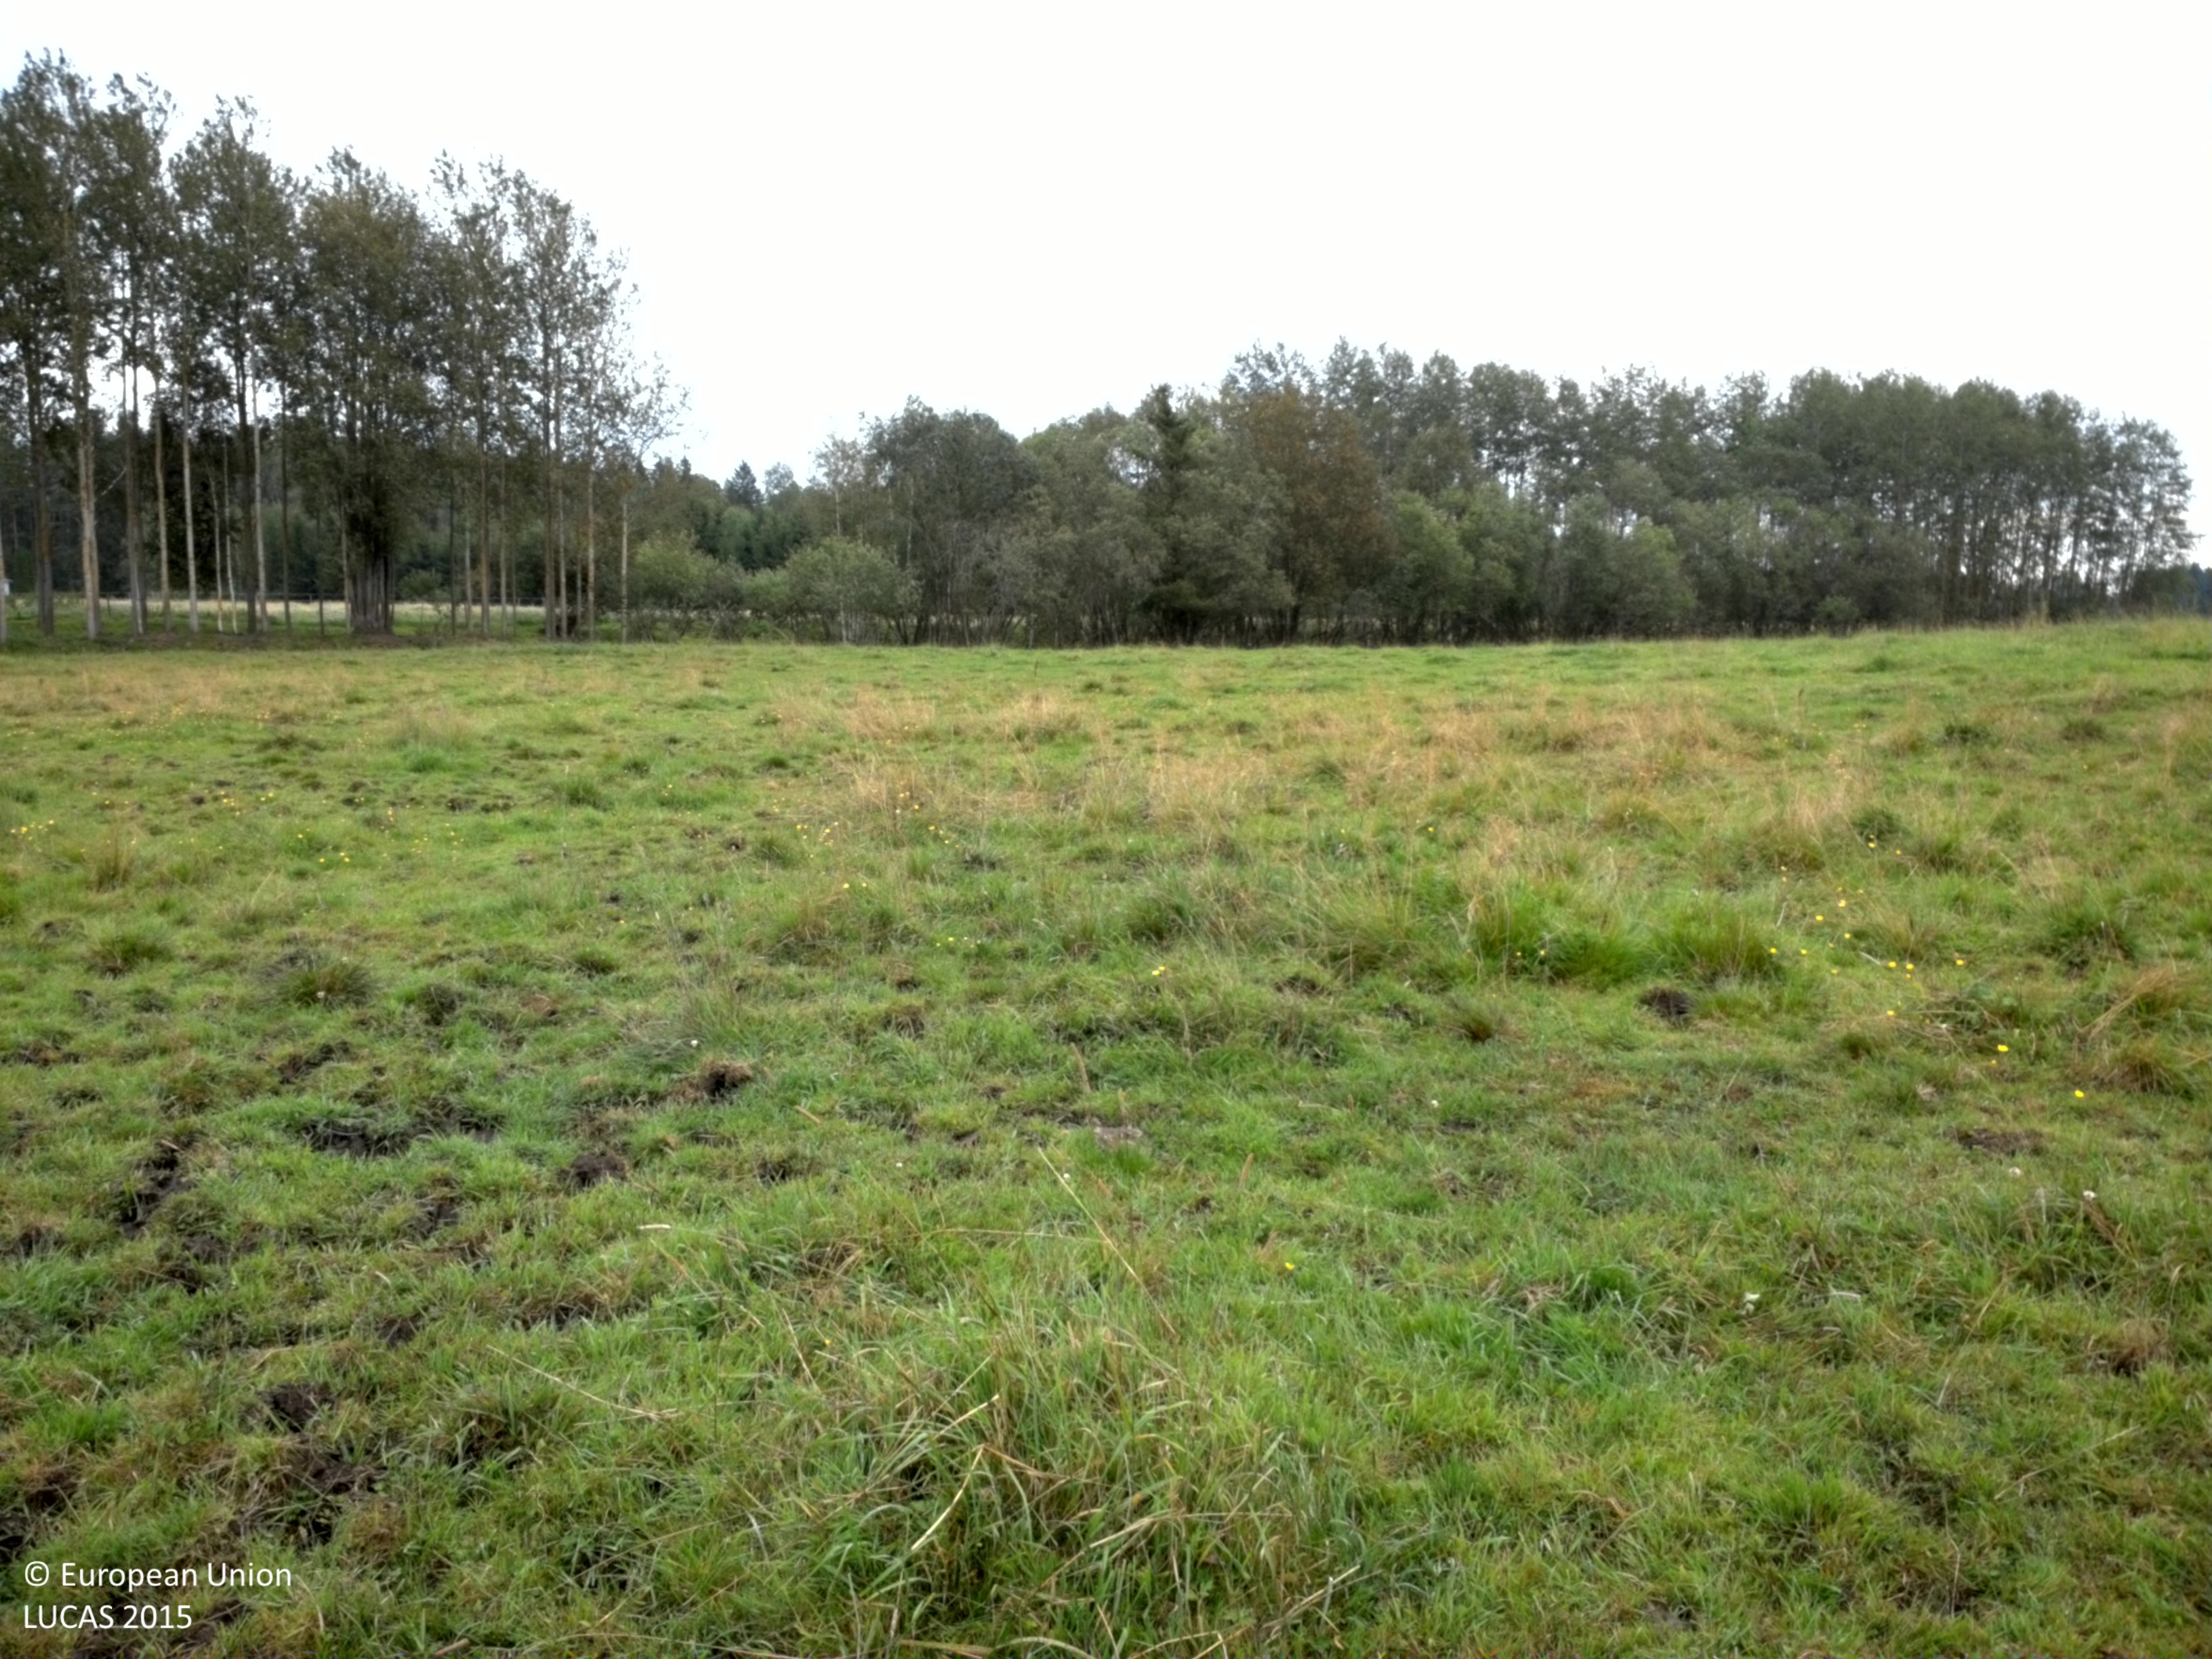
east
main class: Grassland
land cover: Grassland without tree/shrub cover
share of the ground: > 75 %
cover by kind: herbaceous plants 95 %, unconsolidated bare surface 5 %
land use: Agriculture (excluding fallow land and kitchen gardens)
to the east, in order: Grassland without tree/shrub cover; Tracks; Ditches and canals; Broadleaved woodland; Fences; Grassland without tree/shrub cover; Fences; Grassland without tree/shrub cover; Fences; Spruce dominated coniferous woodland; Broadleaved woodland
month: August
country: SE
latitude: 59.8515
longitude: 16.4707
